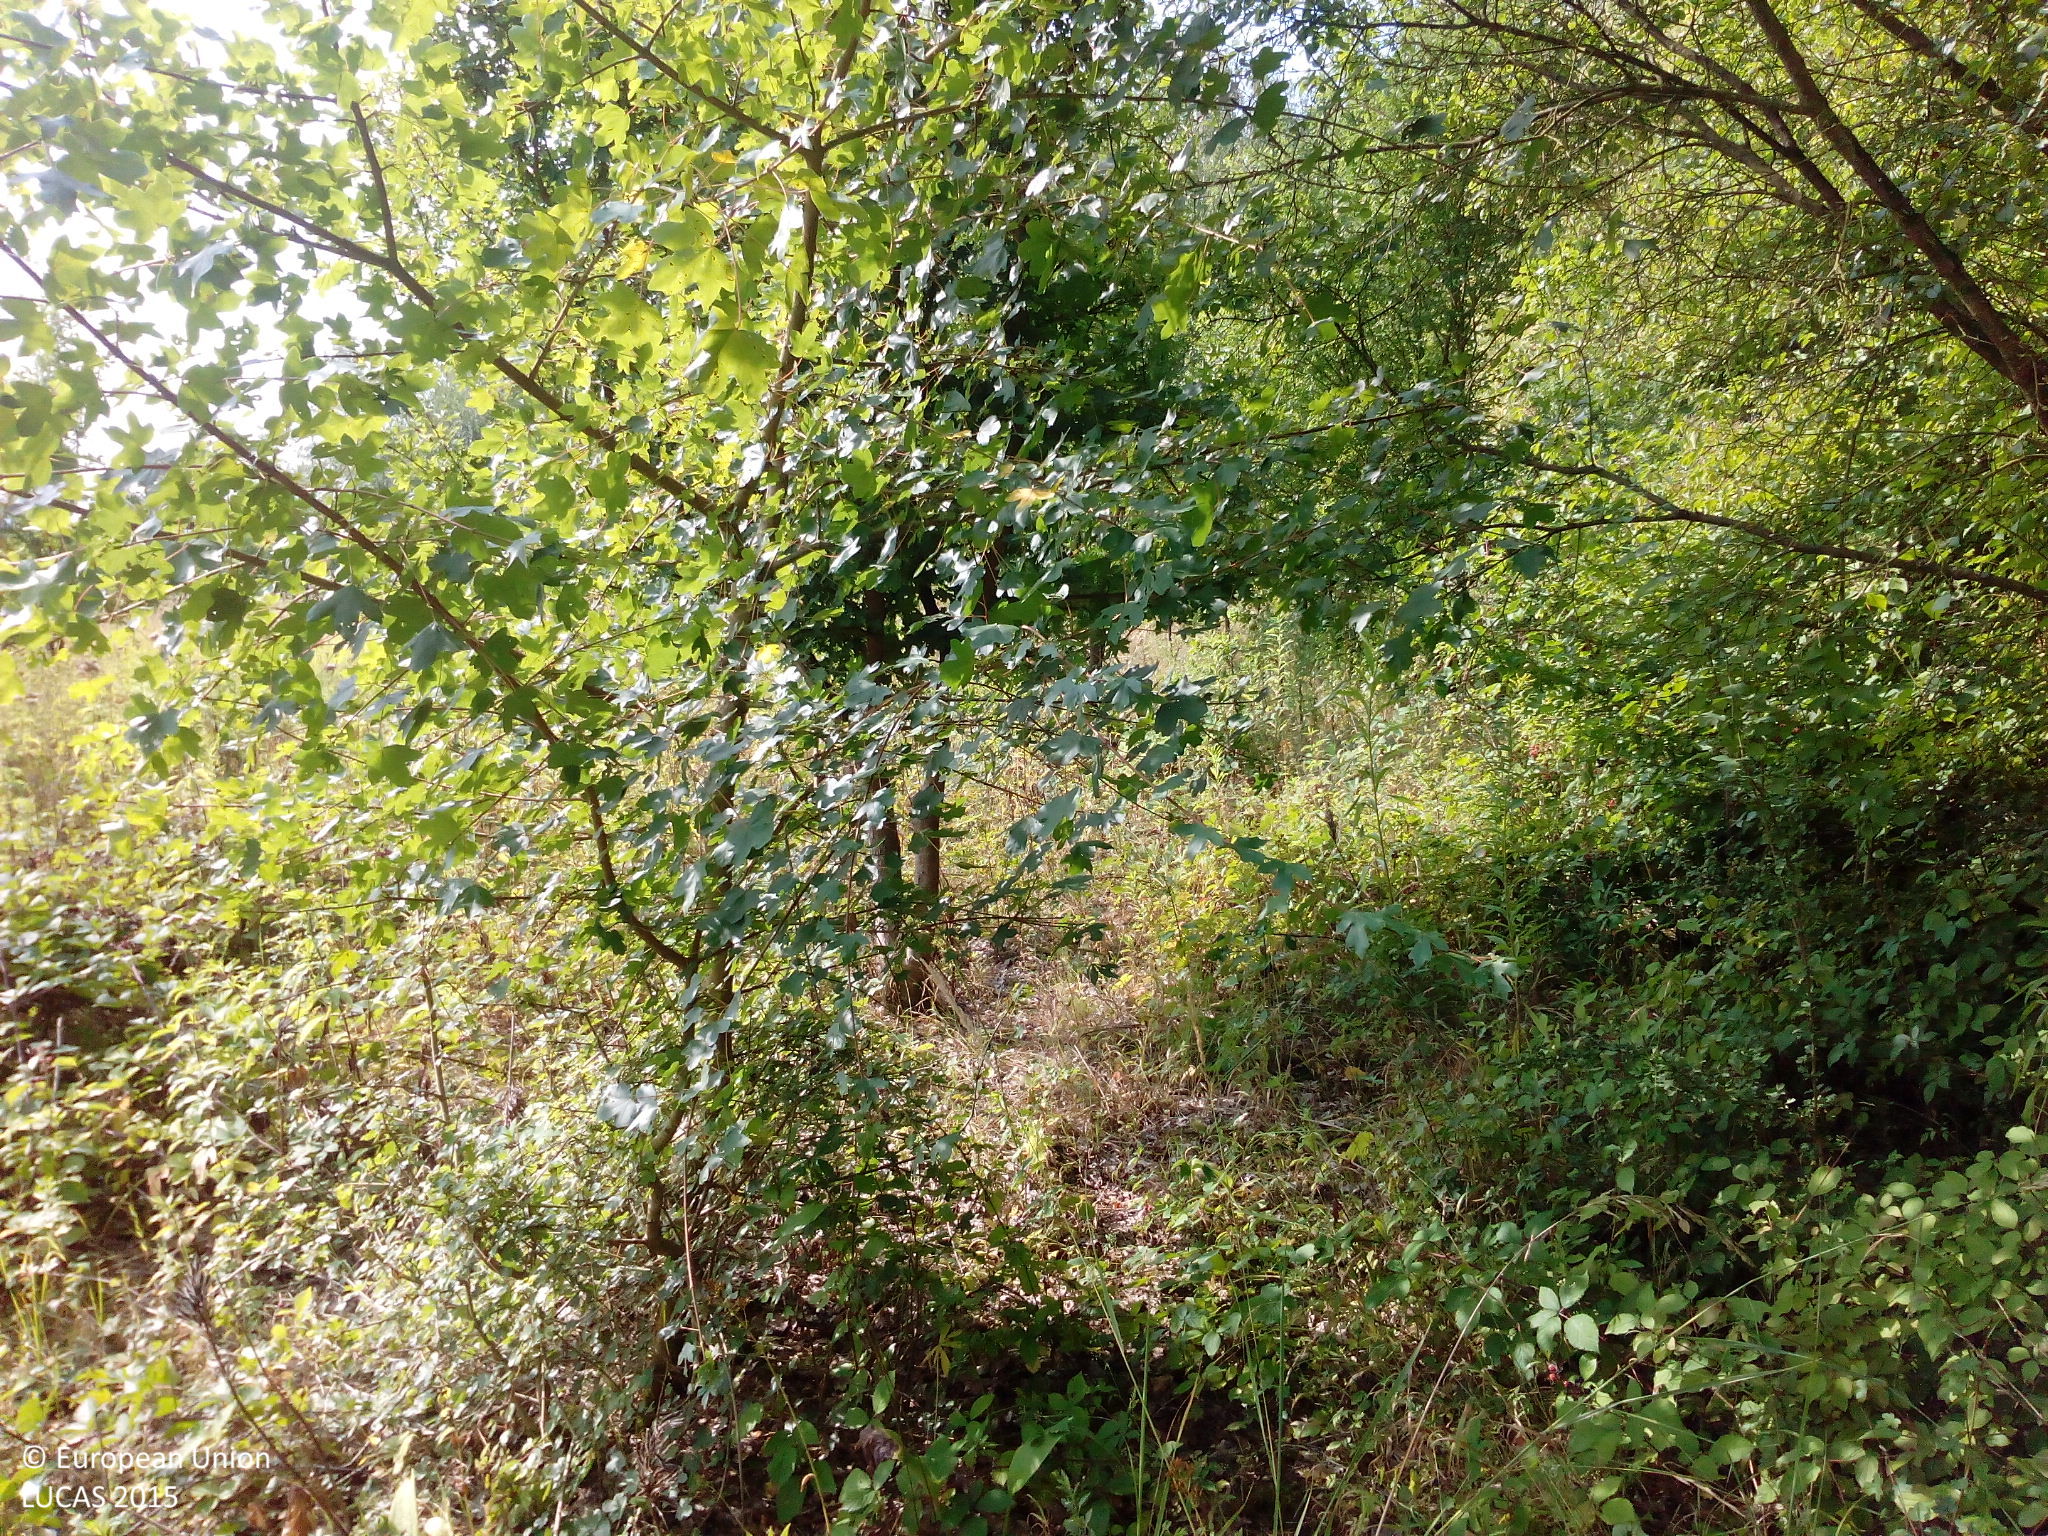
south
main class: Woodland
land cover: Broadleaved woodland
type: acidophilous oak and oak-birch forest
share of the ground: 25 - 50 %
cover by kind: herbaceous plants 50 %, broadleaved forest trees 40 %, shrubs 10 %
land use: Semi-natural and natural areas not in use
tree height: > 5 m
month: August
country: DE
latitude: 50.3370
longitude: 7.5134
